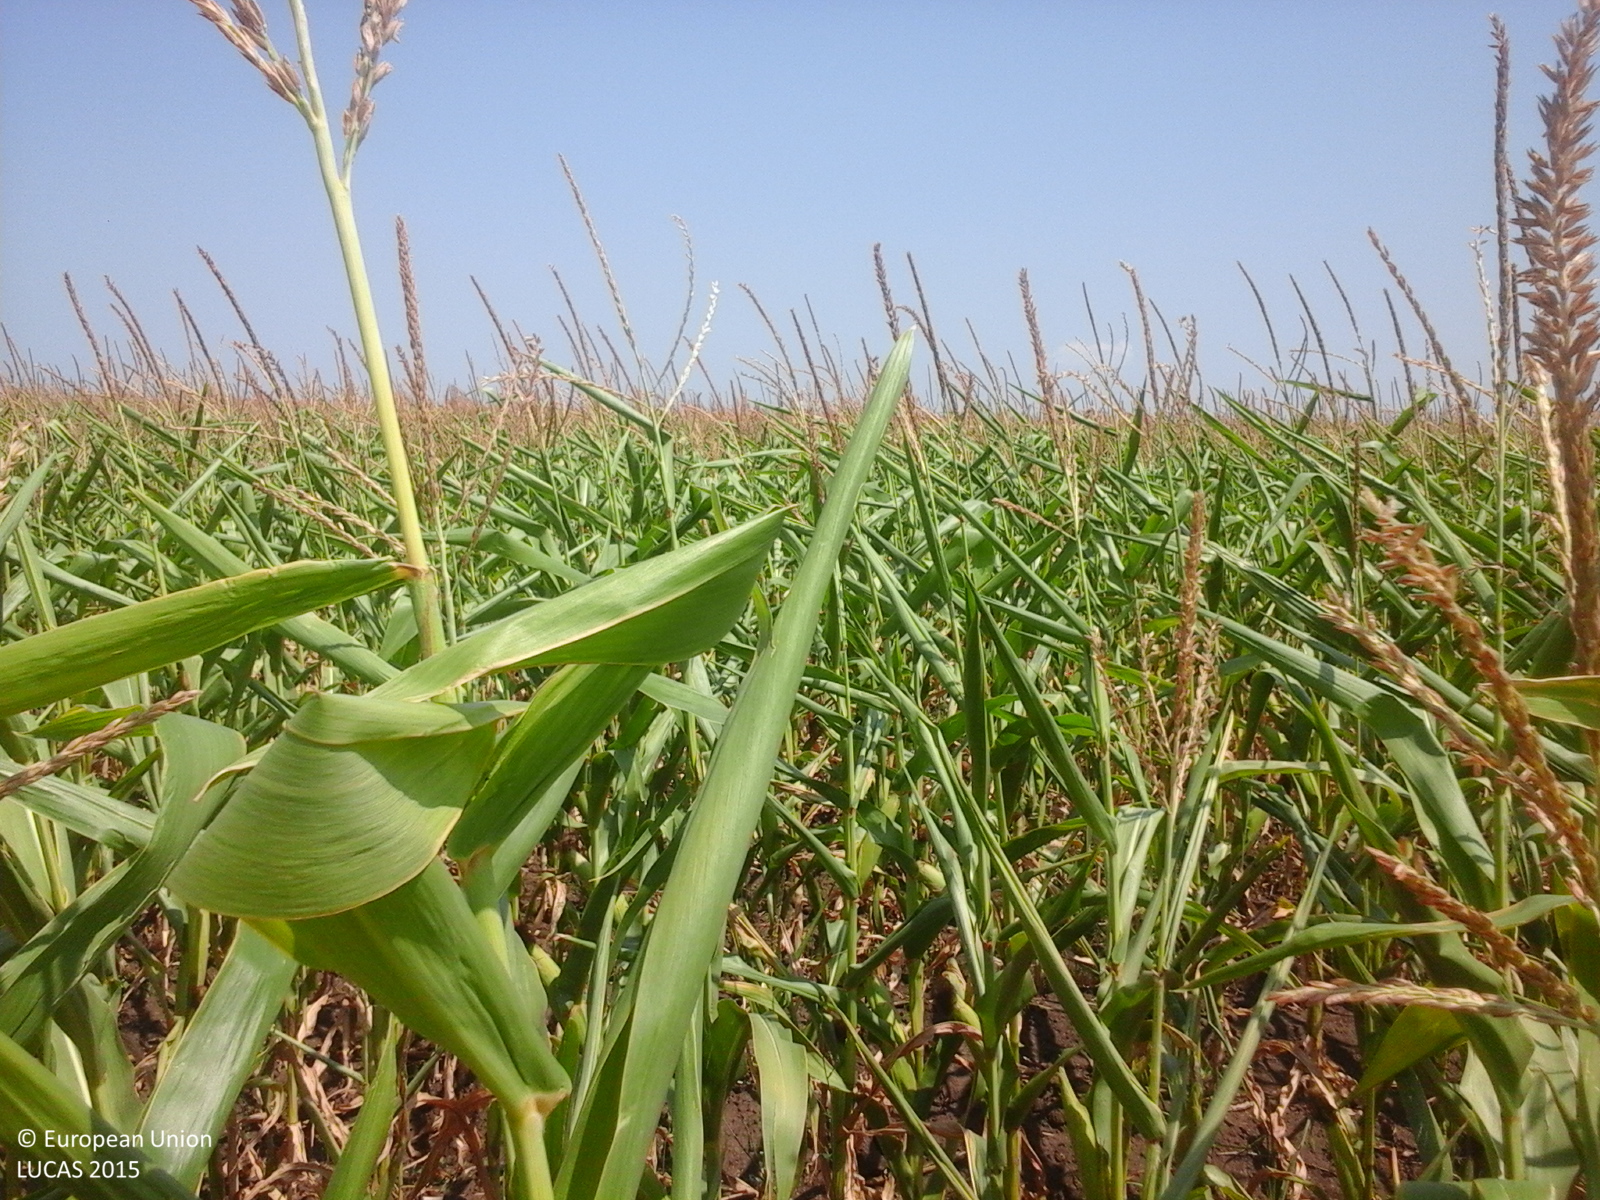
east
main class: Cropland
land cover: Maize
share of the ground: > 75 %
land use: Agriculture (excluding fallow land and kitchen gardens)
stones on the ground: < 10 %
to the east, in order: Maize; Sunflower; Spontaneously vegetated surfaces; Grass margins; Tracks; Grass margins; Sunflower
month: July
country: RO
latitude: 45.8961
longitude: 27.9973
